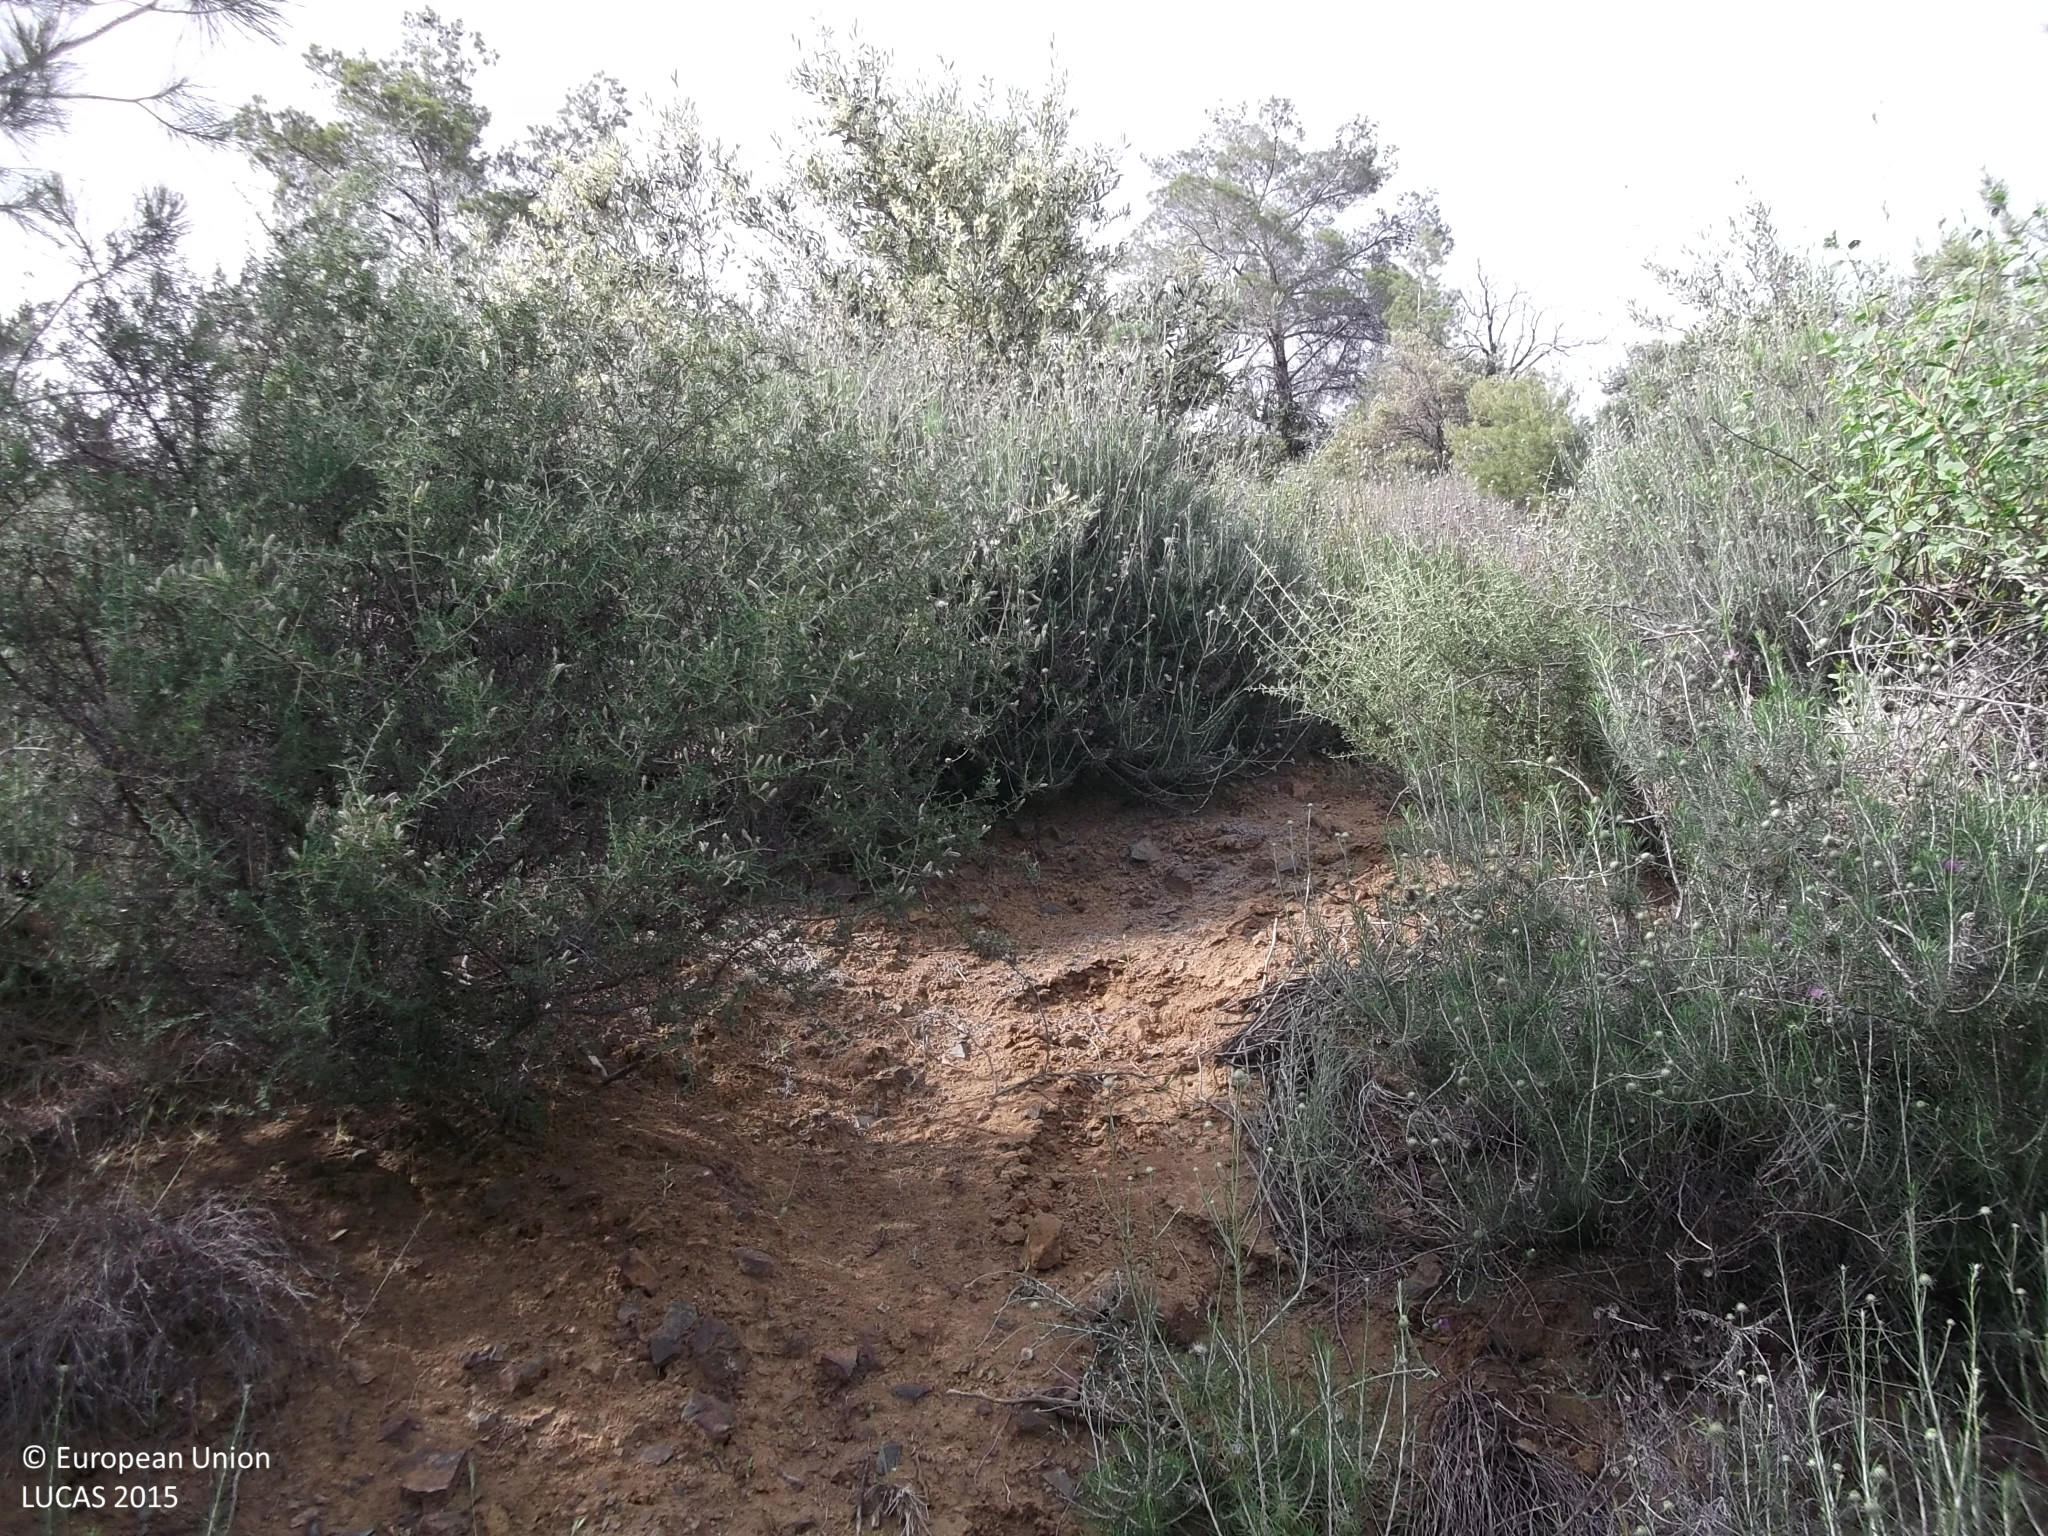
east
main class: Cropland
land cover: Olive groves
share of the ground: 50 - 75 %
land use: Agriculture (excluding fallow land and kitchen gardens)
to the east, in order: Olive groves; Pine dominated coniferous woodland; Shrubland with sparse tree cover; Shrubland without tree cover; Rivers and streams; Shrubland without tree cover; Shrubland with sparse tree cover; Pine dominated coniferous woodland
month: April
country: CY
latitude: 34.8605
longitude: 33.1793
